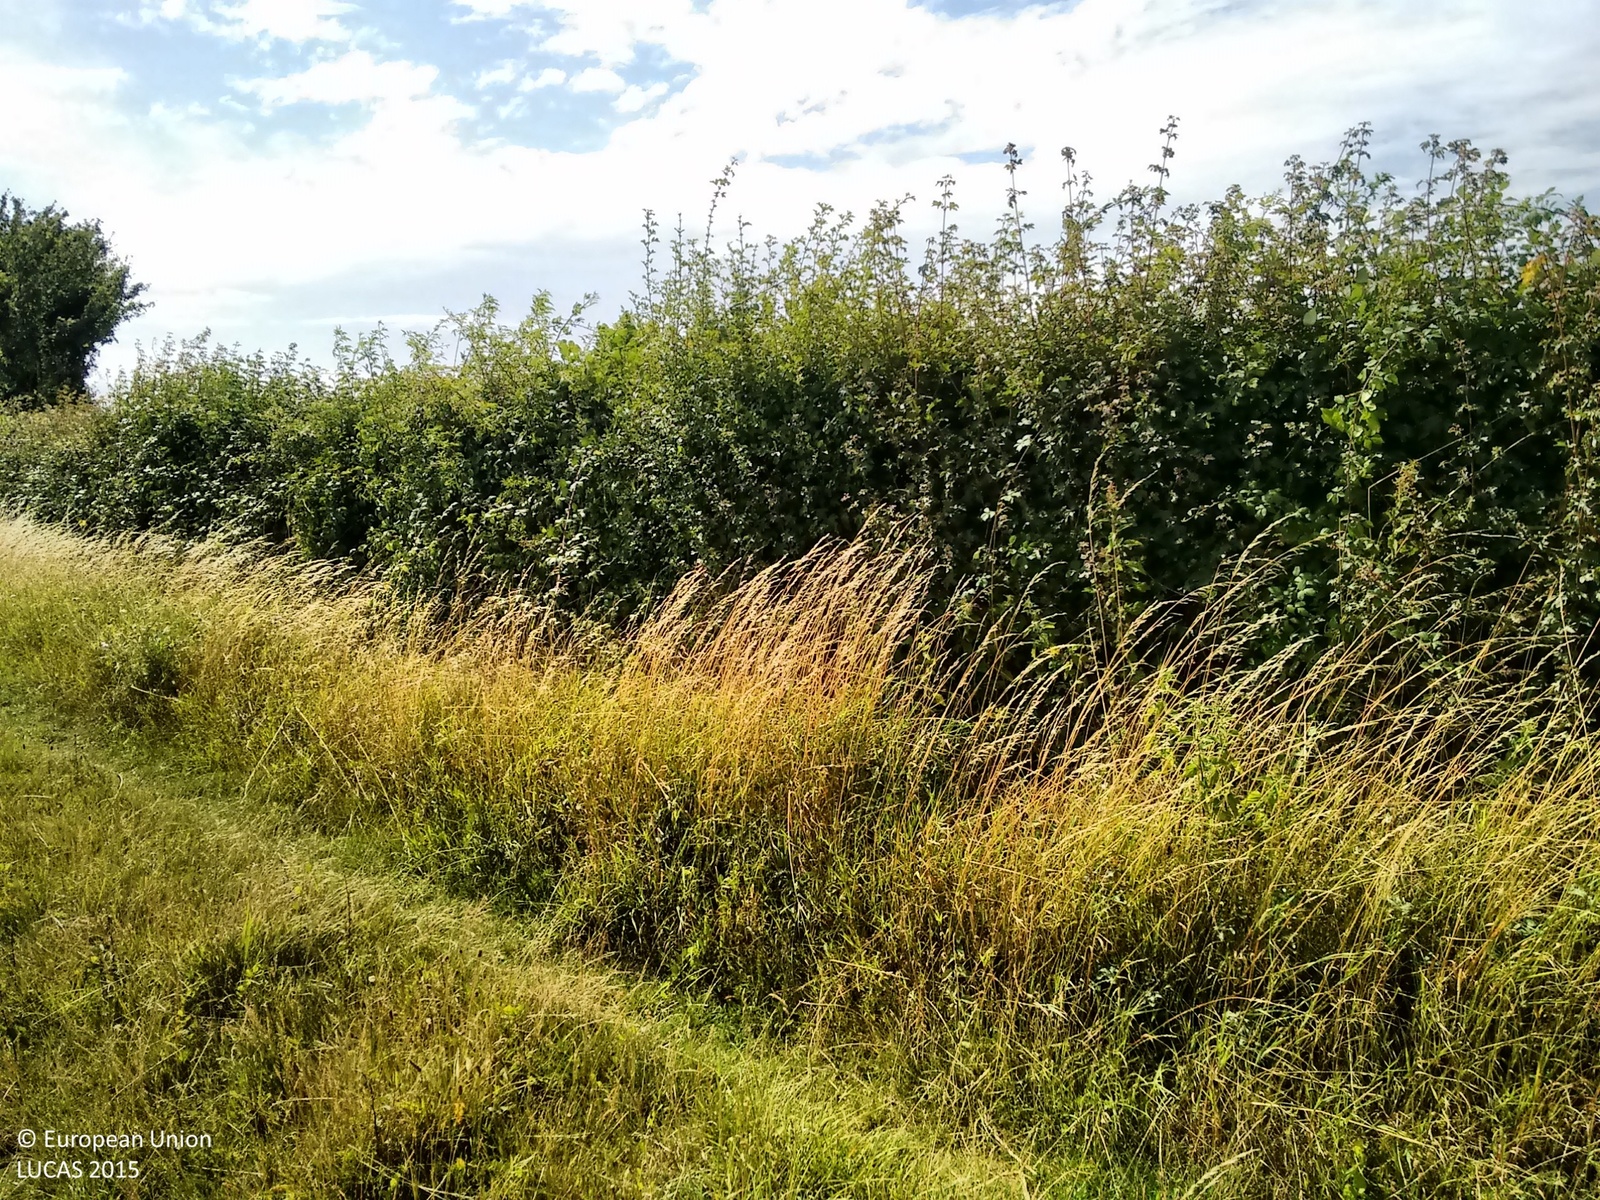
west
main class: Cropland
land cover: Dry pulses
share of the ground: > 75 %
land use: Agriculture (excluding fallow land and kitchen gardens)
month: August
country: GB
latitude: 51.9795
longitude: 0.5236
